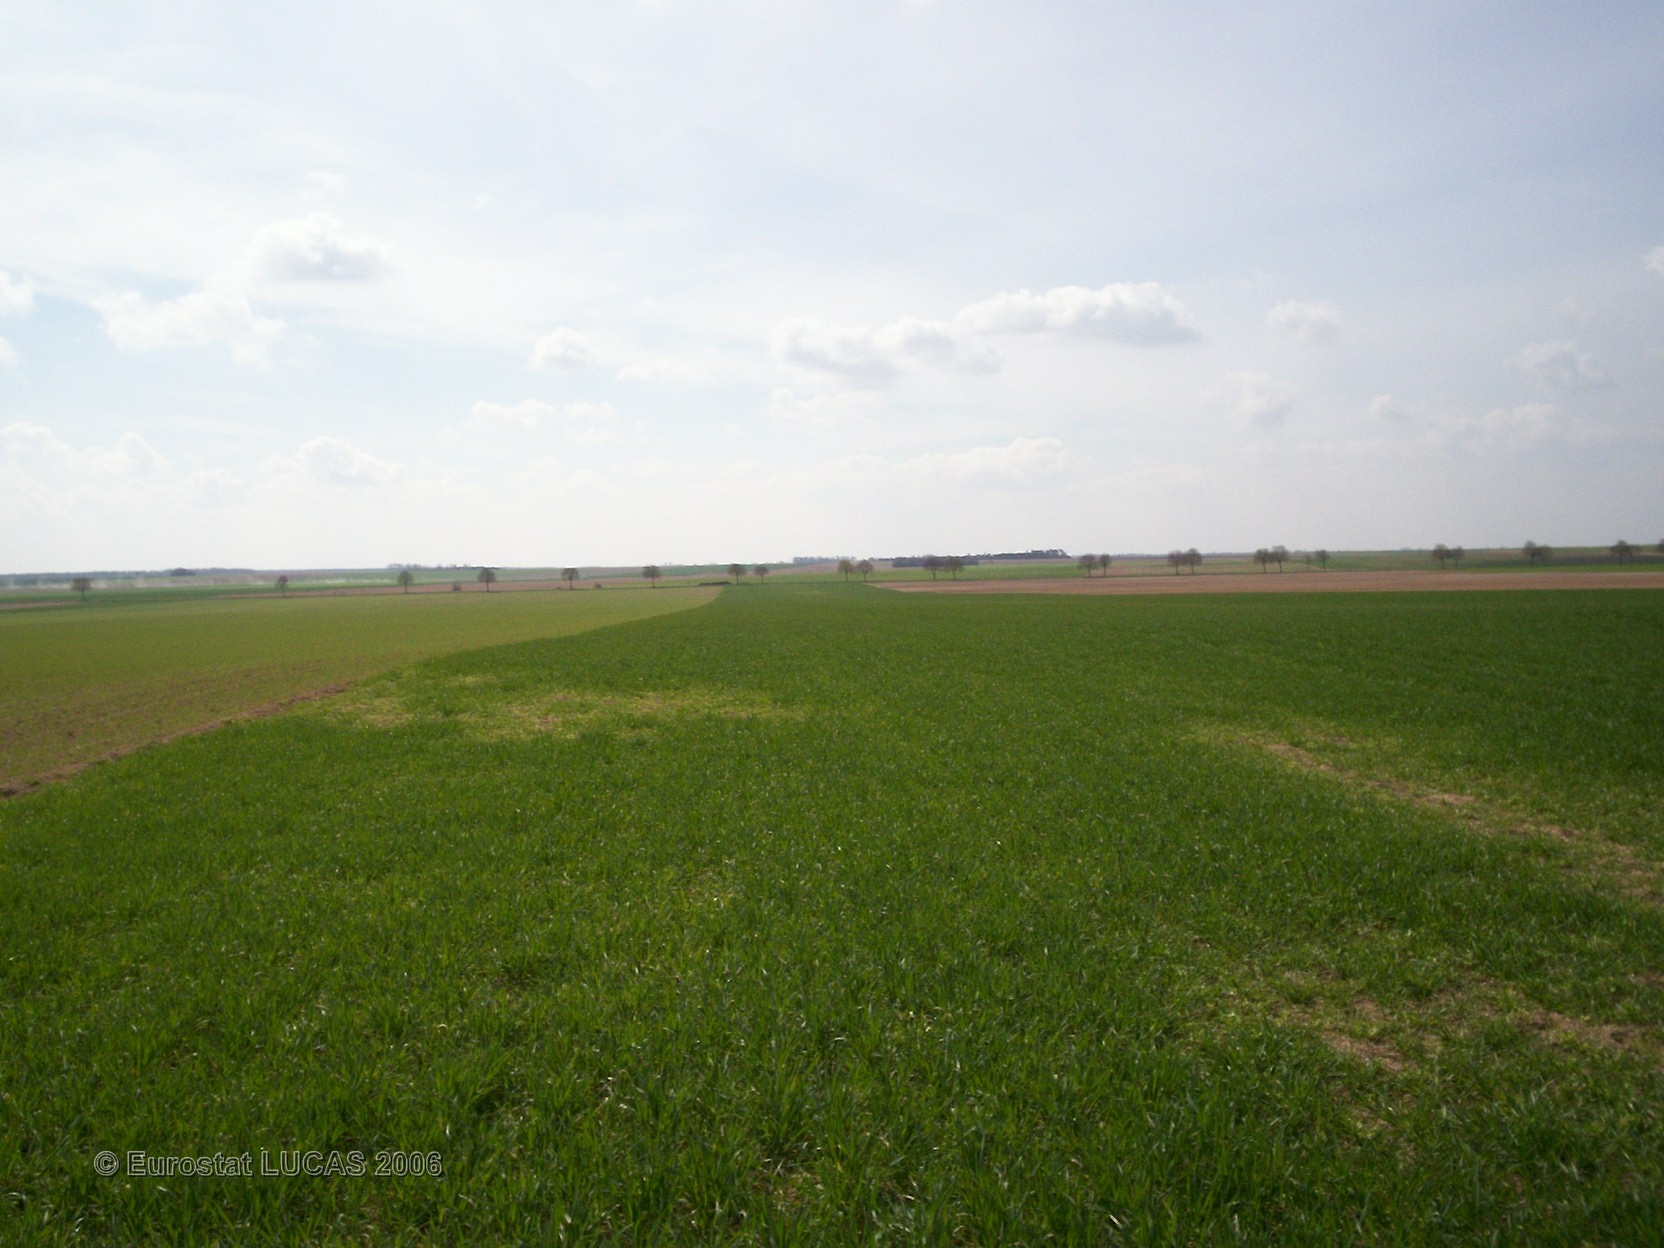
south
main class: Cropland
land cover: Barley
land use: Agriculture (excluding fallow land and kitchen gardens)
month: April
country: FR
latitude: 49.1985
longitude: 4.3832
